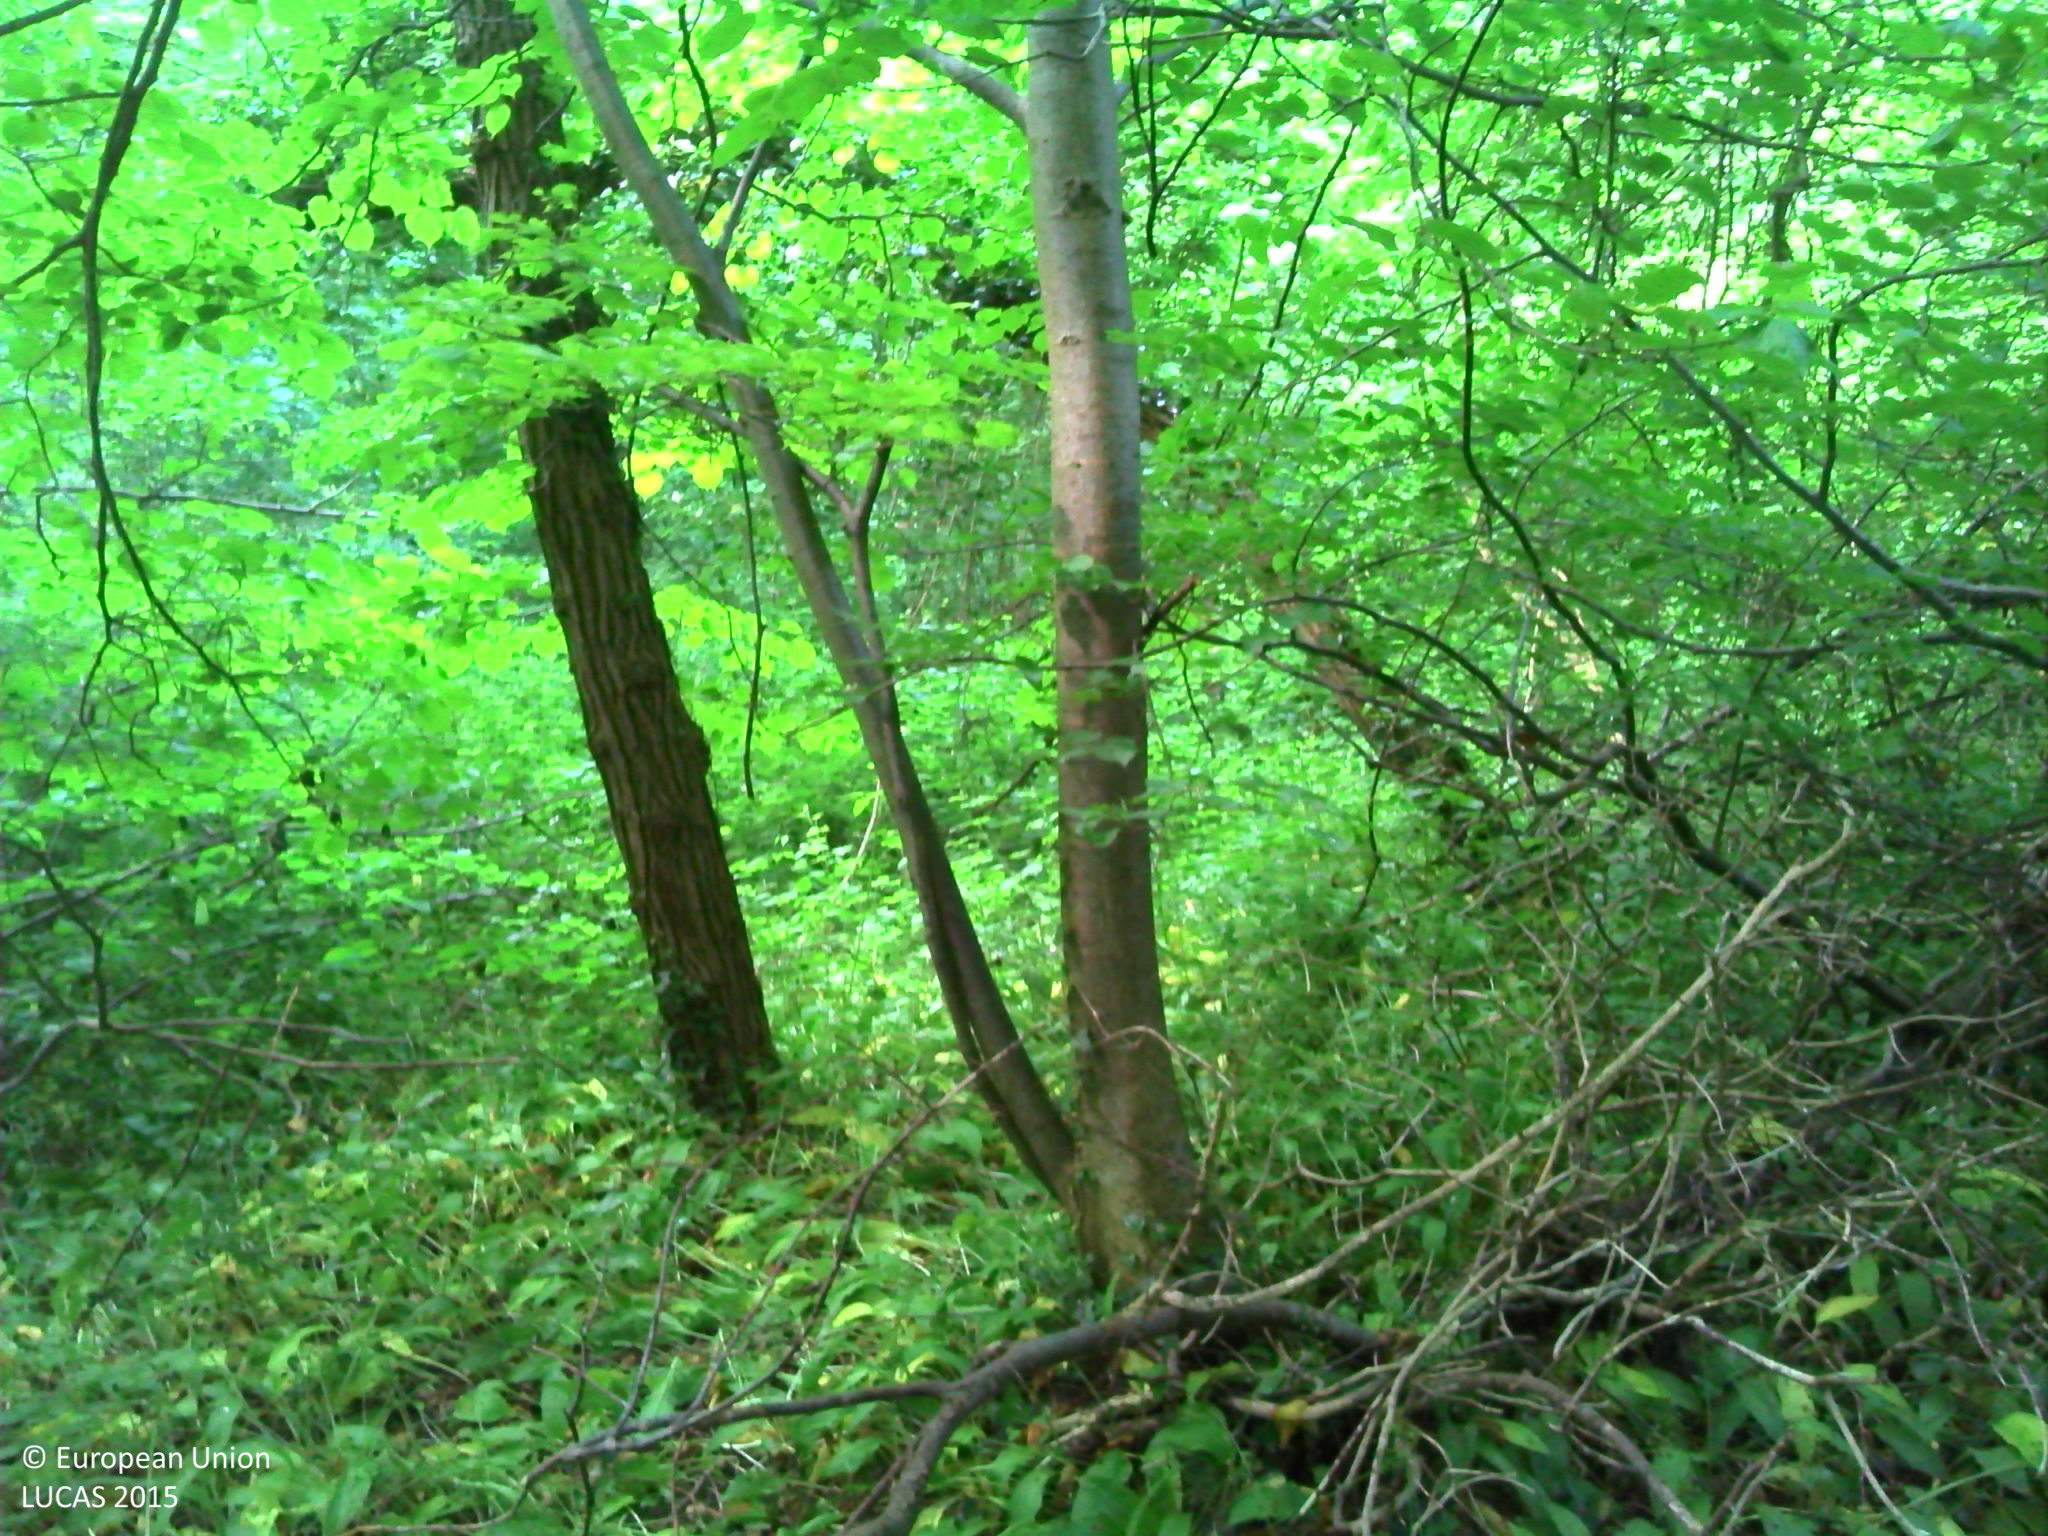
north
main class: Woodland
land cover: Broadleaved woodland
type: beech forest
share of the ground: > 75 %
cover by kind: broadleaved forest trees 100 %
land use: Forestry
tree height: > 5 m
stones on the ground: < 10 %
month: June
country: FR
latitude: 49.5533
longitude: 3.2877
